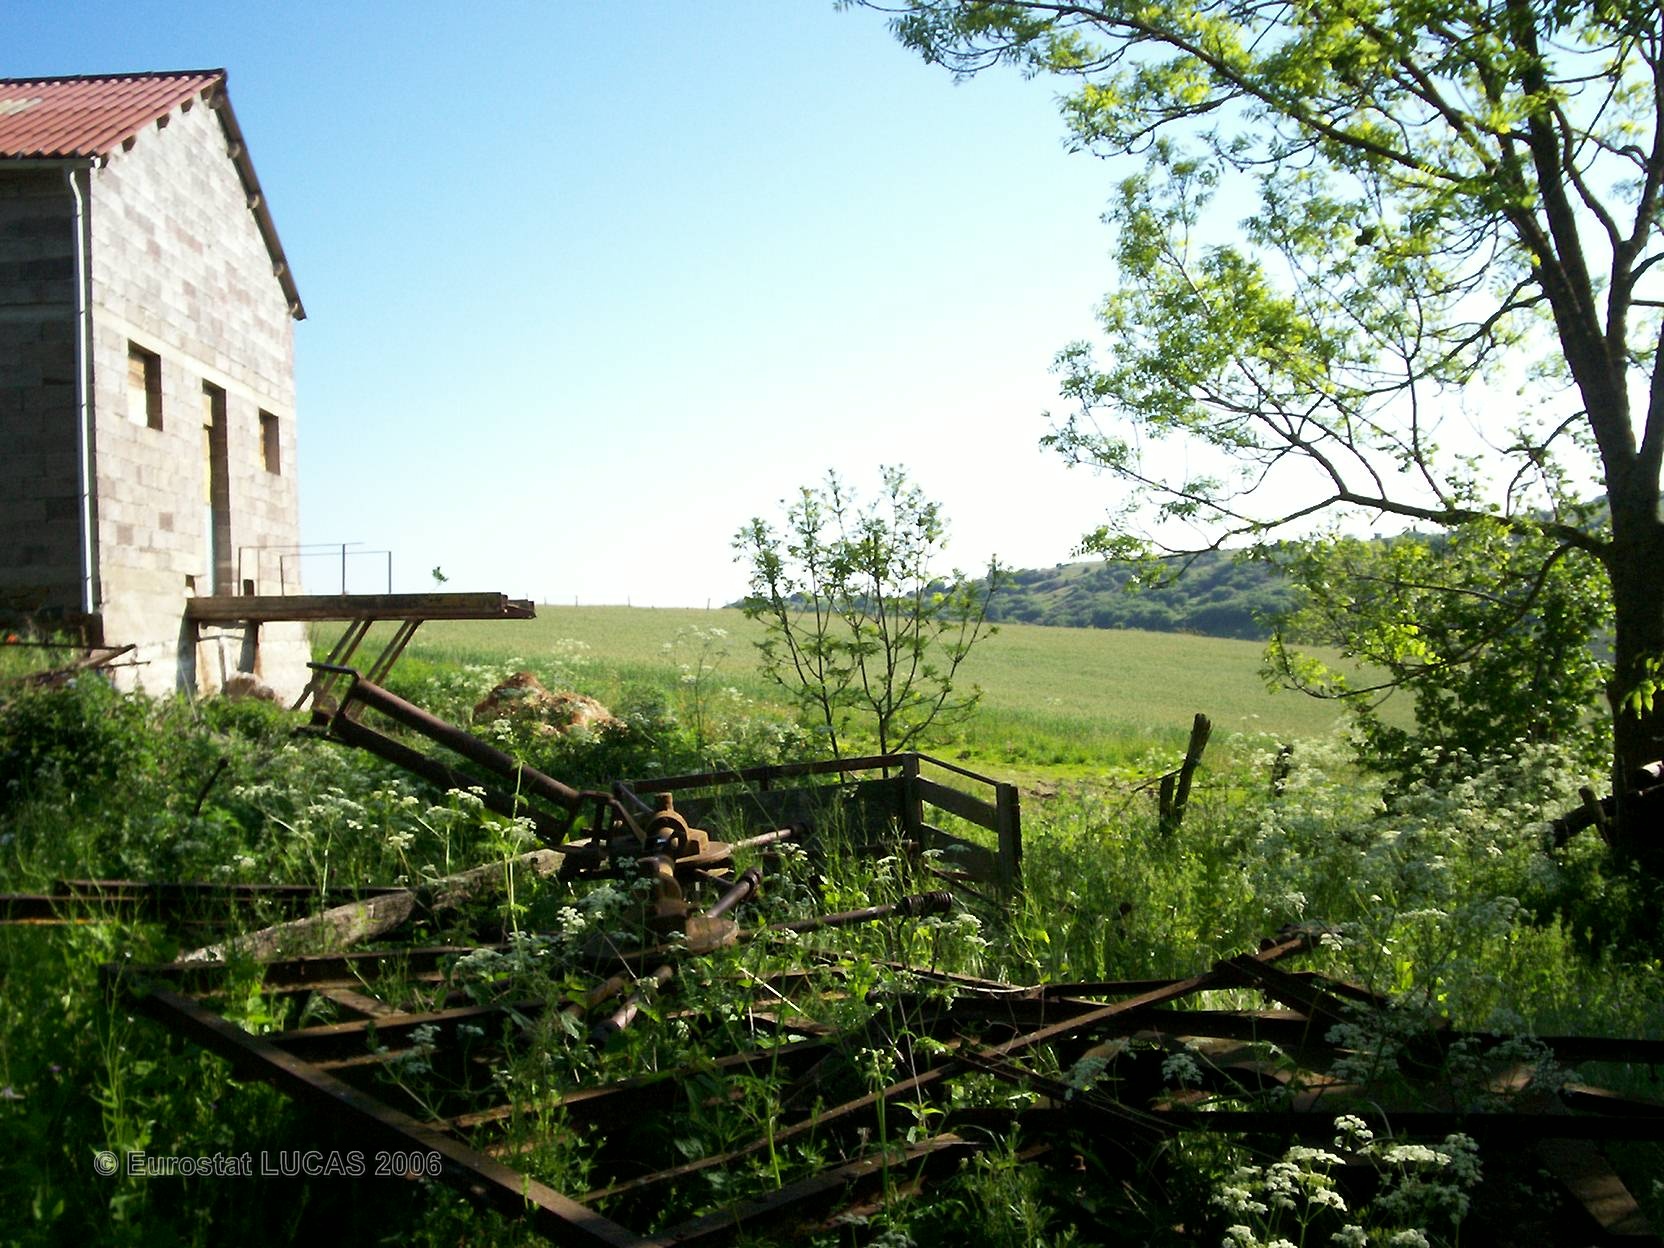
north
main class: Grassland
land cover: Grassland with sparse tree/shrub cover
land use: Agriculture (excluding fallow land and kitchen gardens)
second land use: Residential
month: June
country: FR
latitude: 45.1436
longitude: 3.2493
